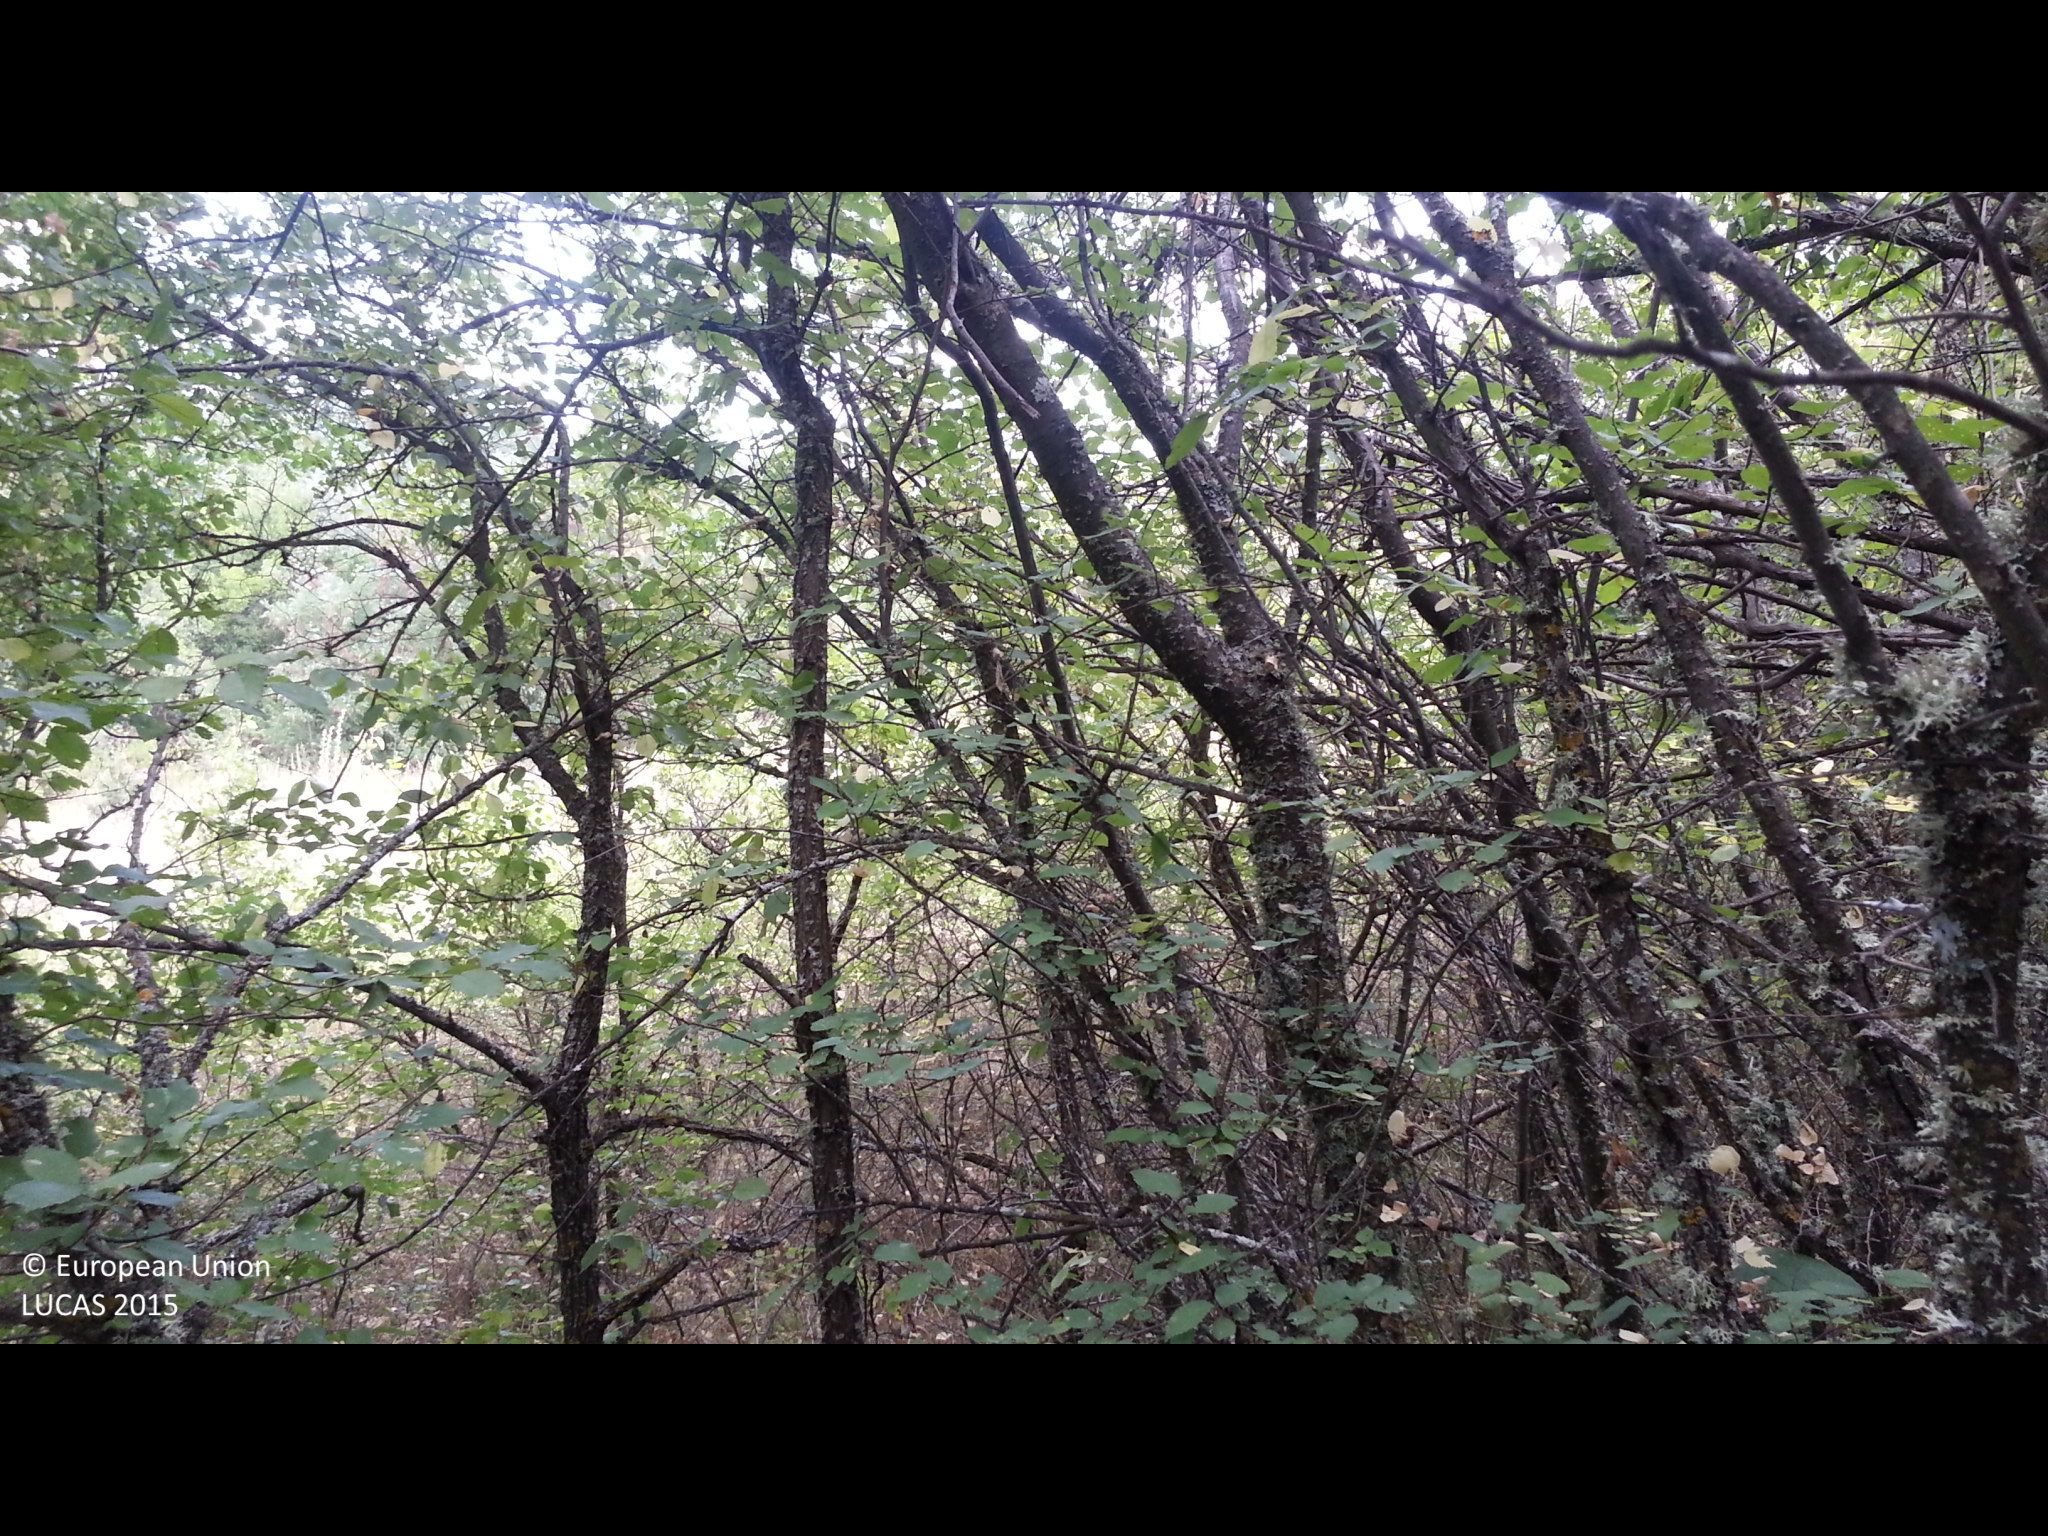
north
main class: Woodland
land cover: Broadleaved woodland
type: mesophytic deciduous forest
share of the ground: > 75 %
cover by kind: broadleaved forest trees 95 %, shrubs 5 %
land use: Forestry
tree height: < 5 m
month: September
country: BG
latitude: 42.3492
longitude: 22.6591
